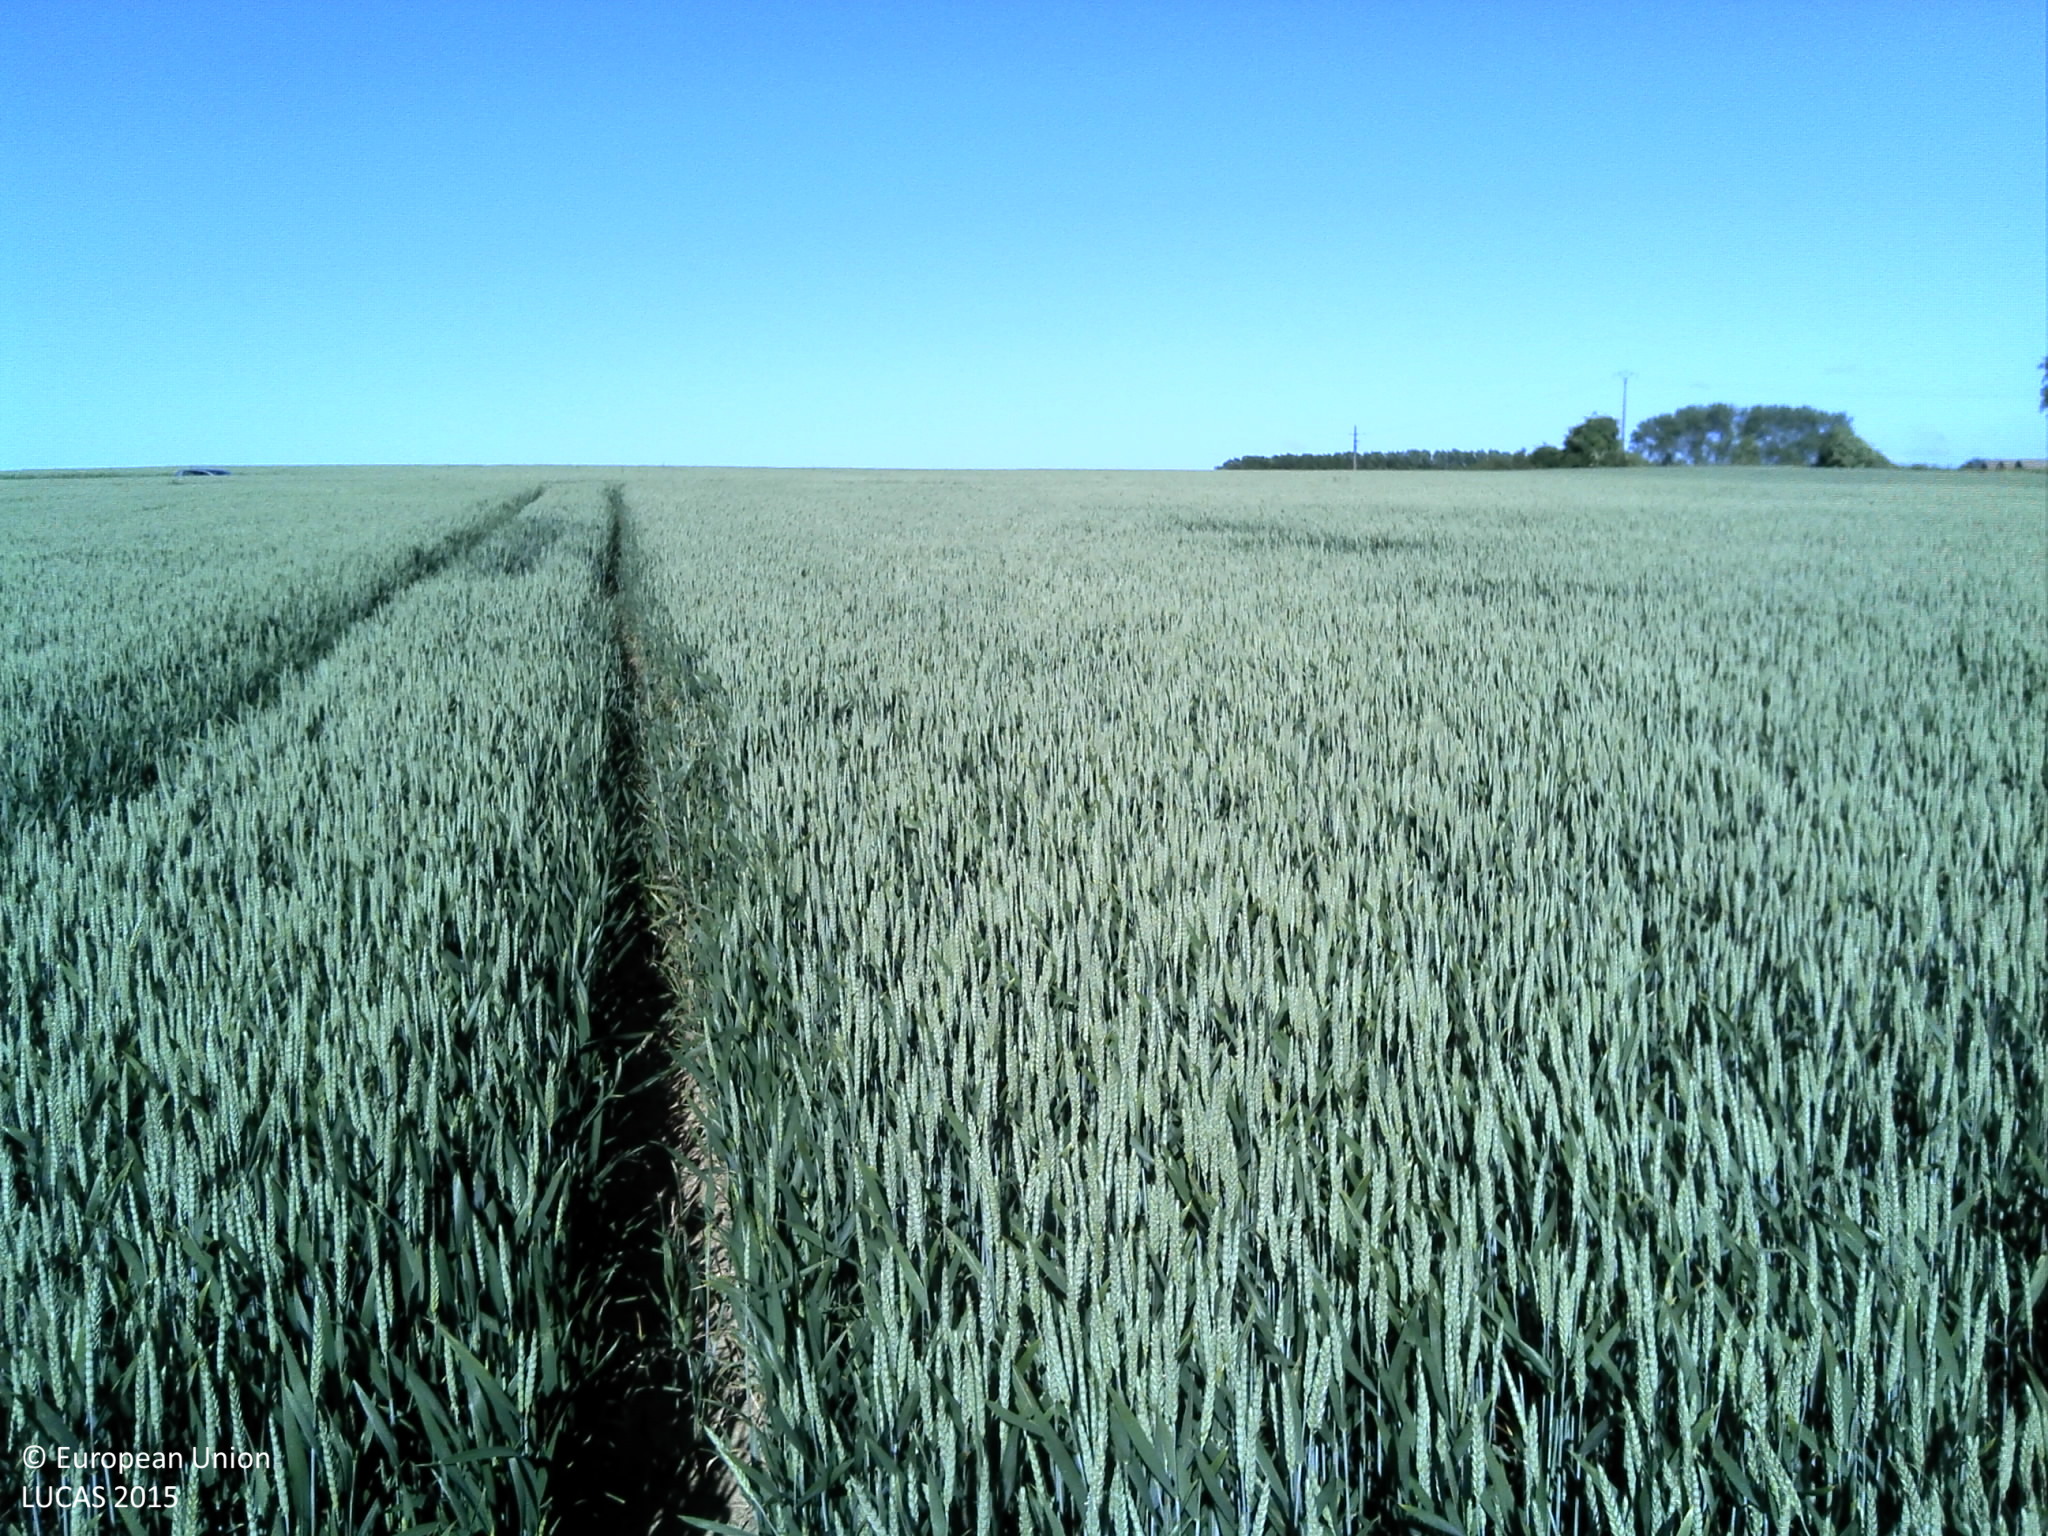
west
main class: Cropland
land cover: Common wheat
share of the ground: > 75 %
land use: Agriculture (excluding fallow land and kitchen gardens)
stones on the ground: < 10 %
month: June
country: FR
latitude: 49.5990
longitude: 1.0817
